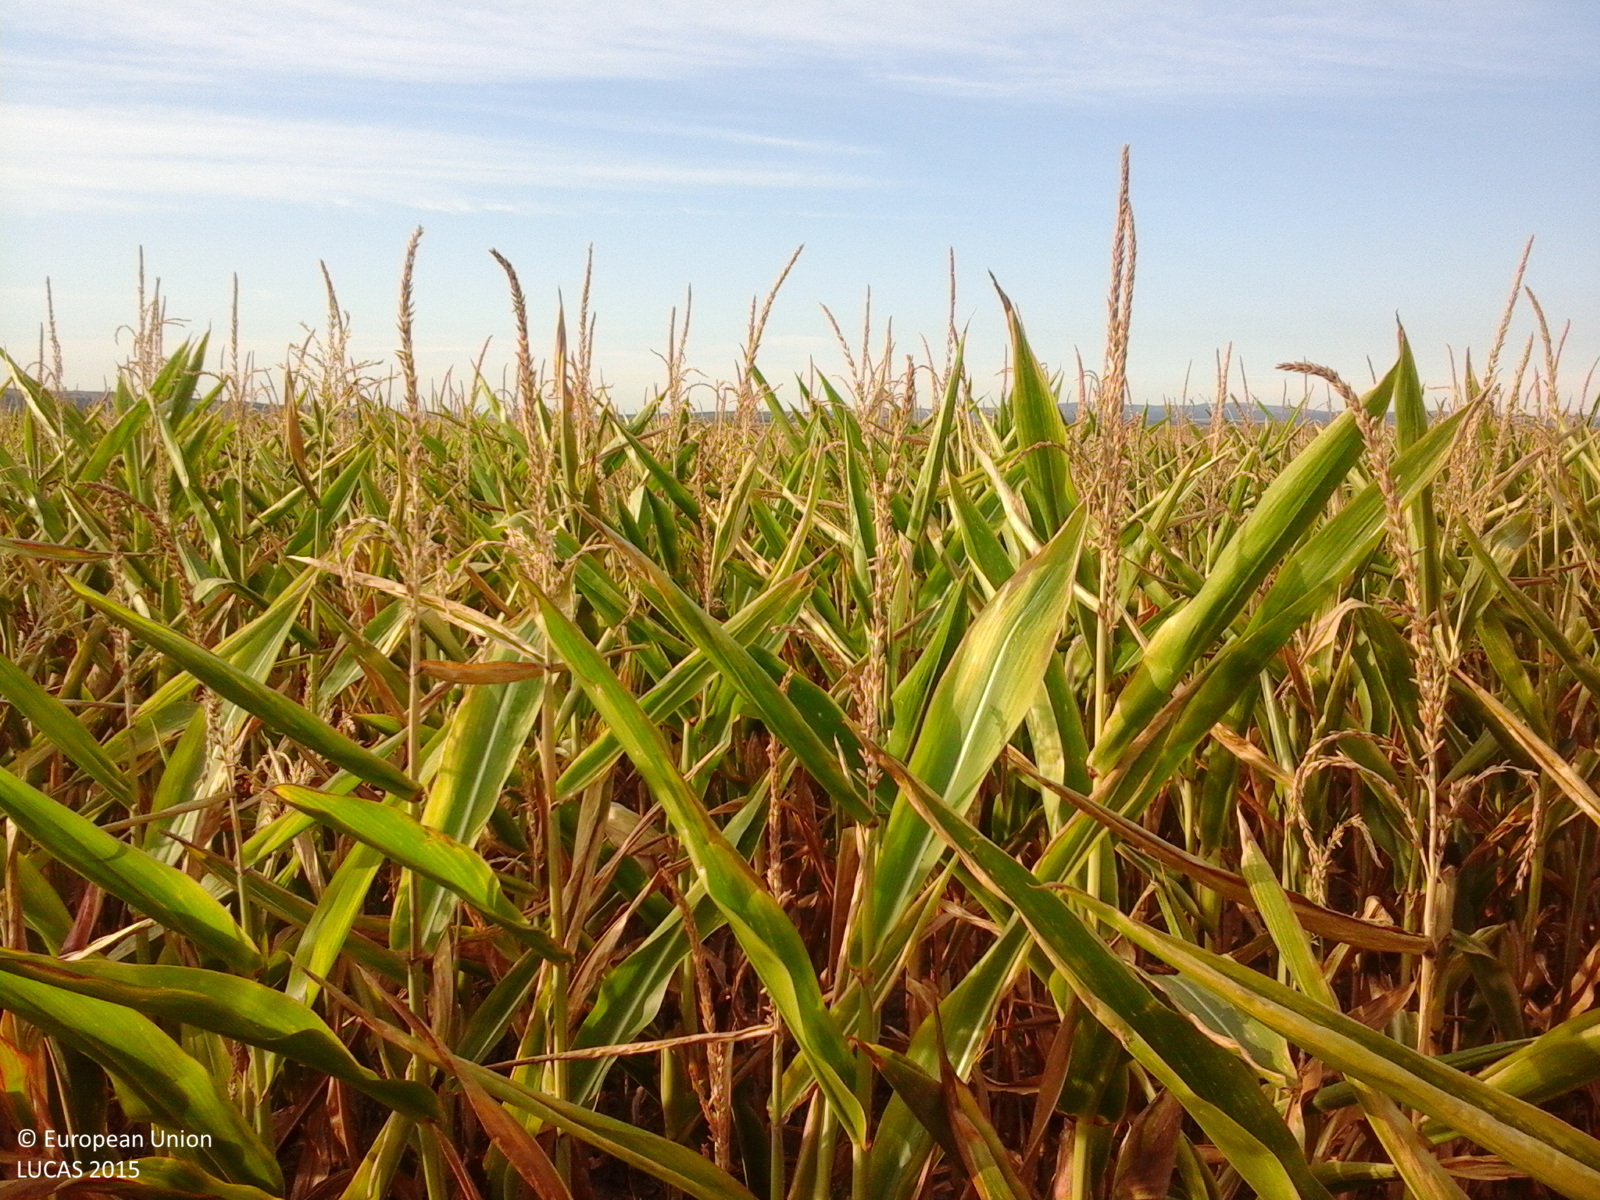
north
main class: Cropland
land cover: Maize
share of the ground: > 75 %
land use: Agriculture (excluding fallow land and kitchen gardens)
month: August
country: RO
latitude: 45.0478
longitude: 21.5714
